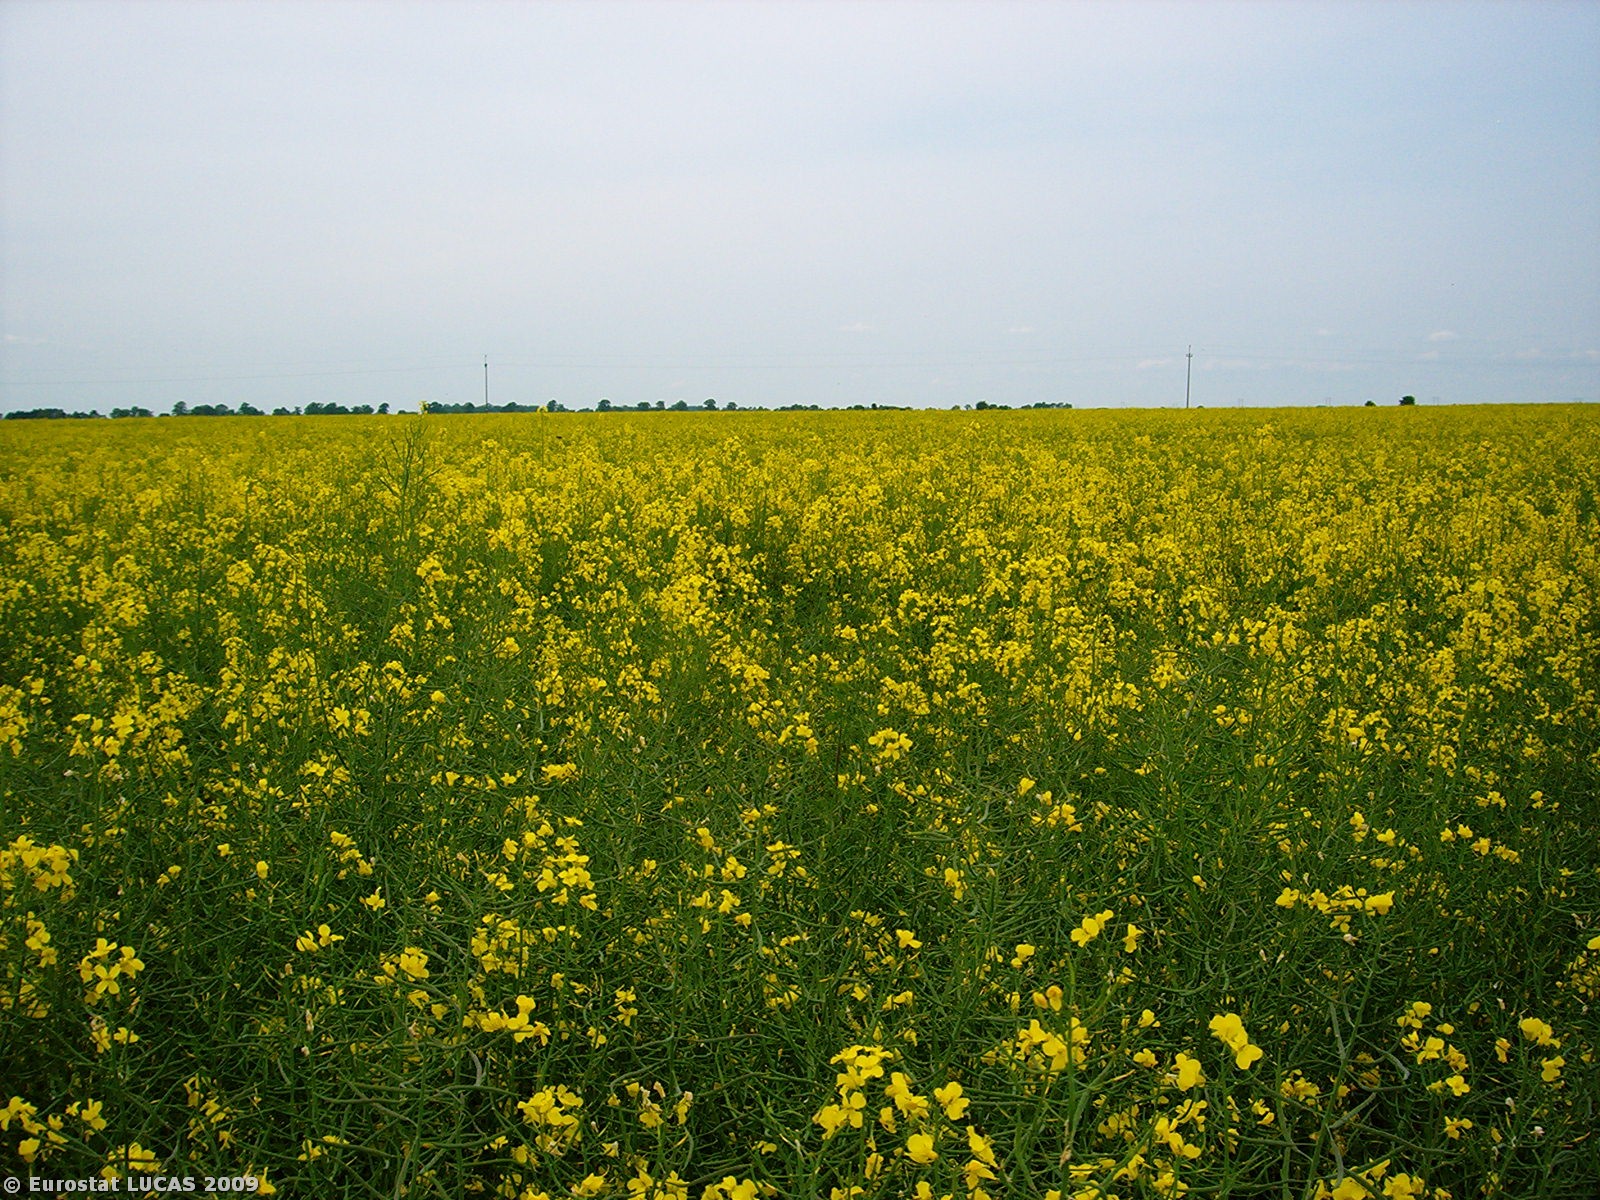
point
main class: Cropland
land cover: Rape and turnip rape
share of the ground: > 75 %
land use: Agriculture (excluding fallow land and kitchen gardens)
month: May
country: PL
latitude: 52.6520
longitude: 16.4669
